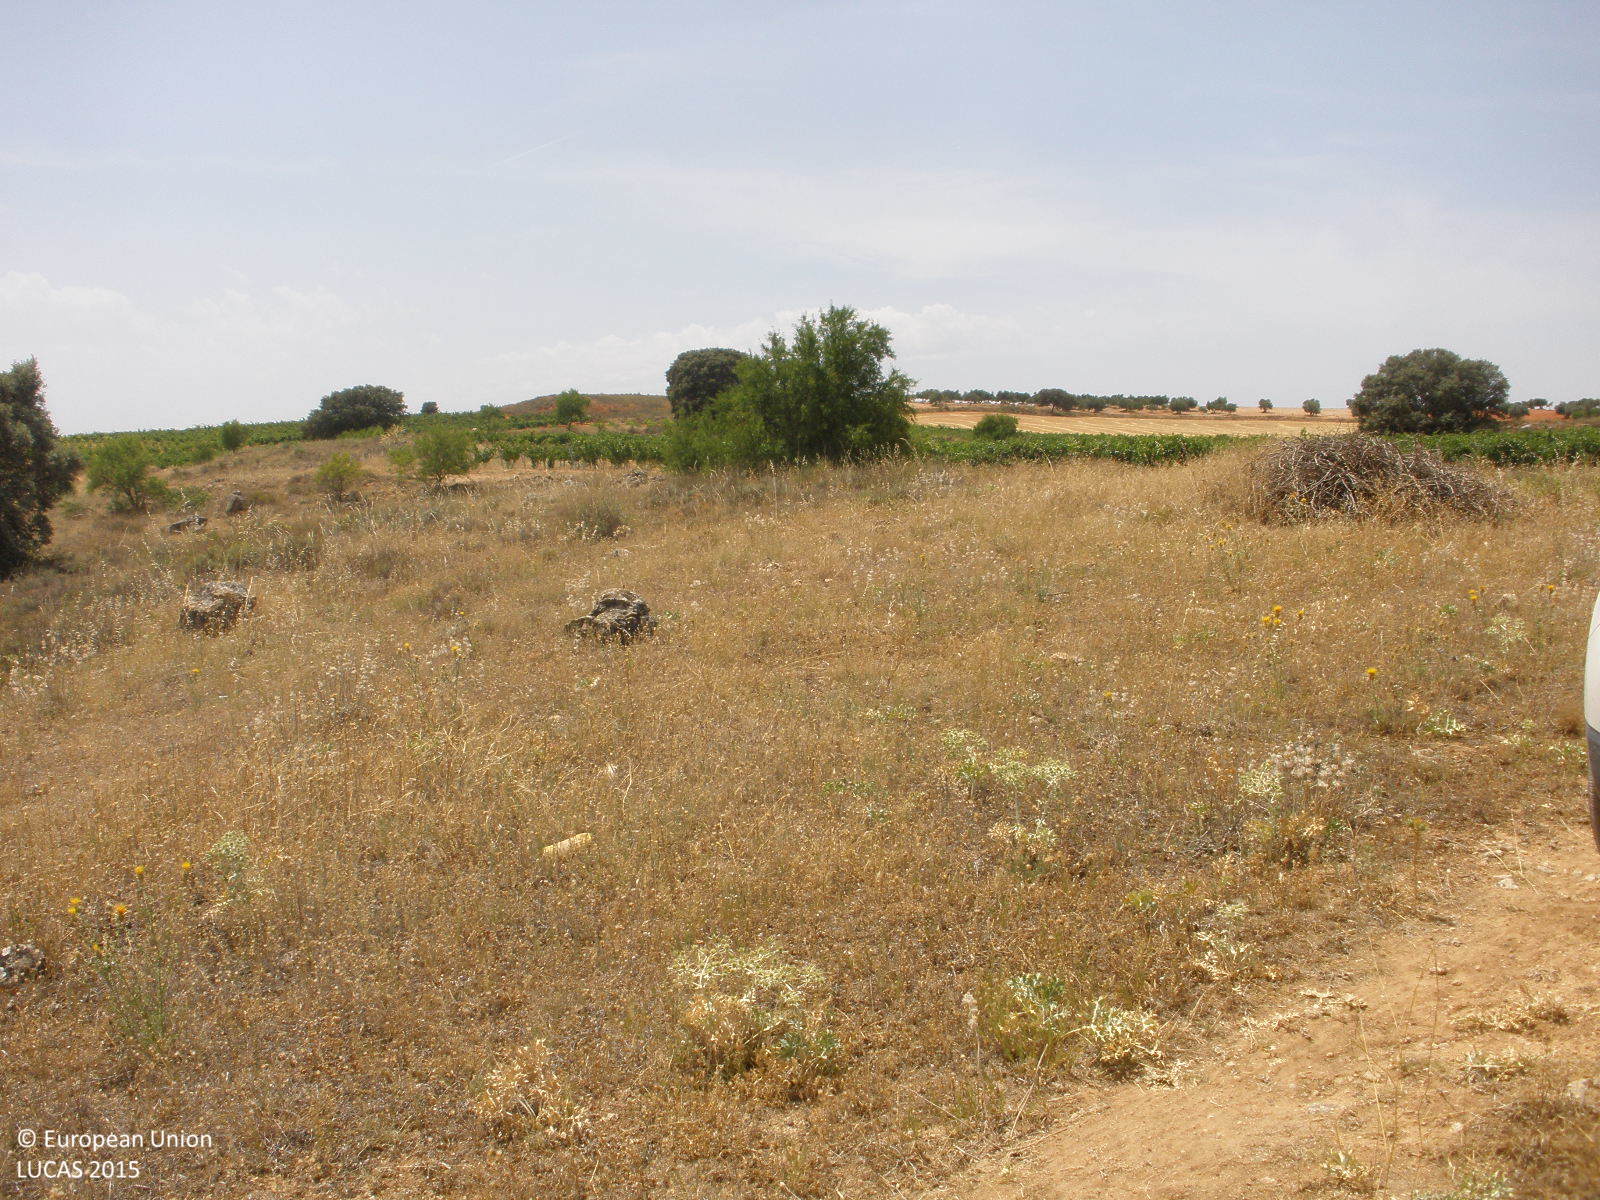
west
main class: Grassland
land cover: Grassland without tree/shrub cover
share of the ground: > 75 %
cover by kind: herbaceous plants 85 %, consolidated bare surface 10 %, shrubs 5 %
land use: Abandoned areas
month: July
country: ES
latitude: 39.8676
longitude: -3.3179
